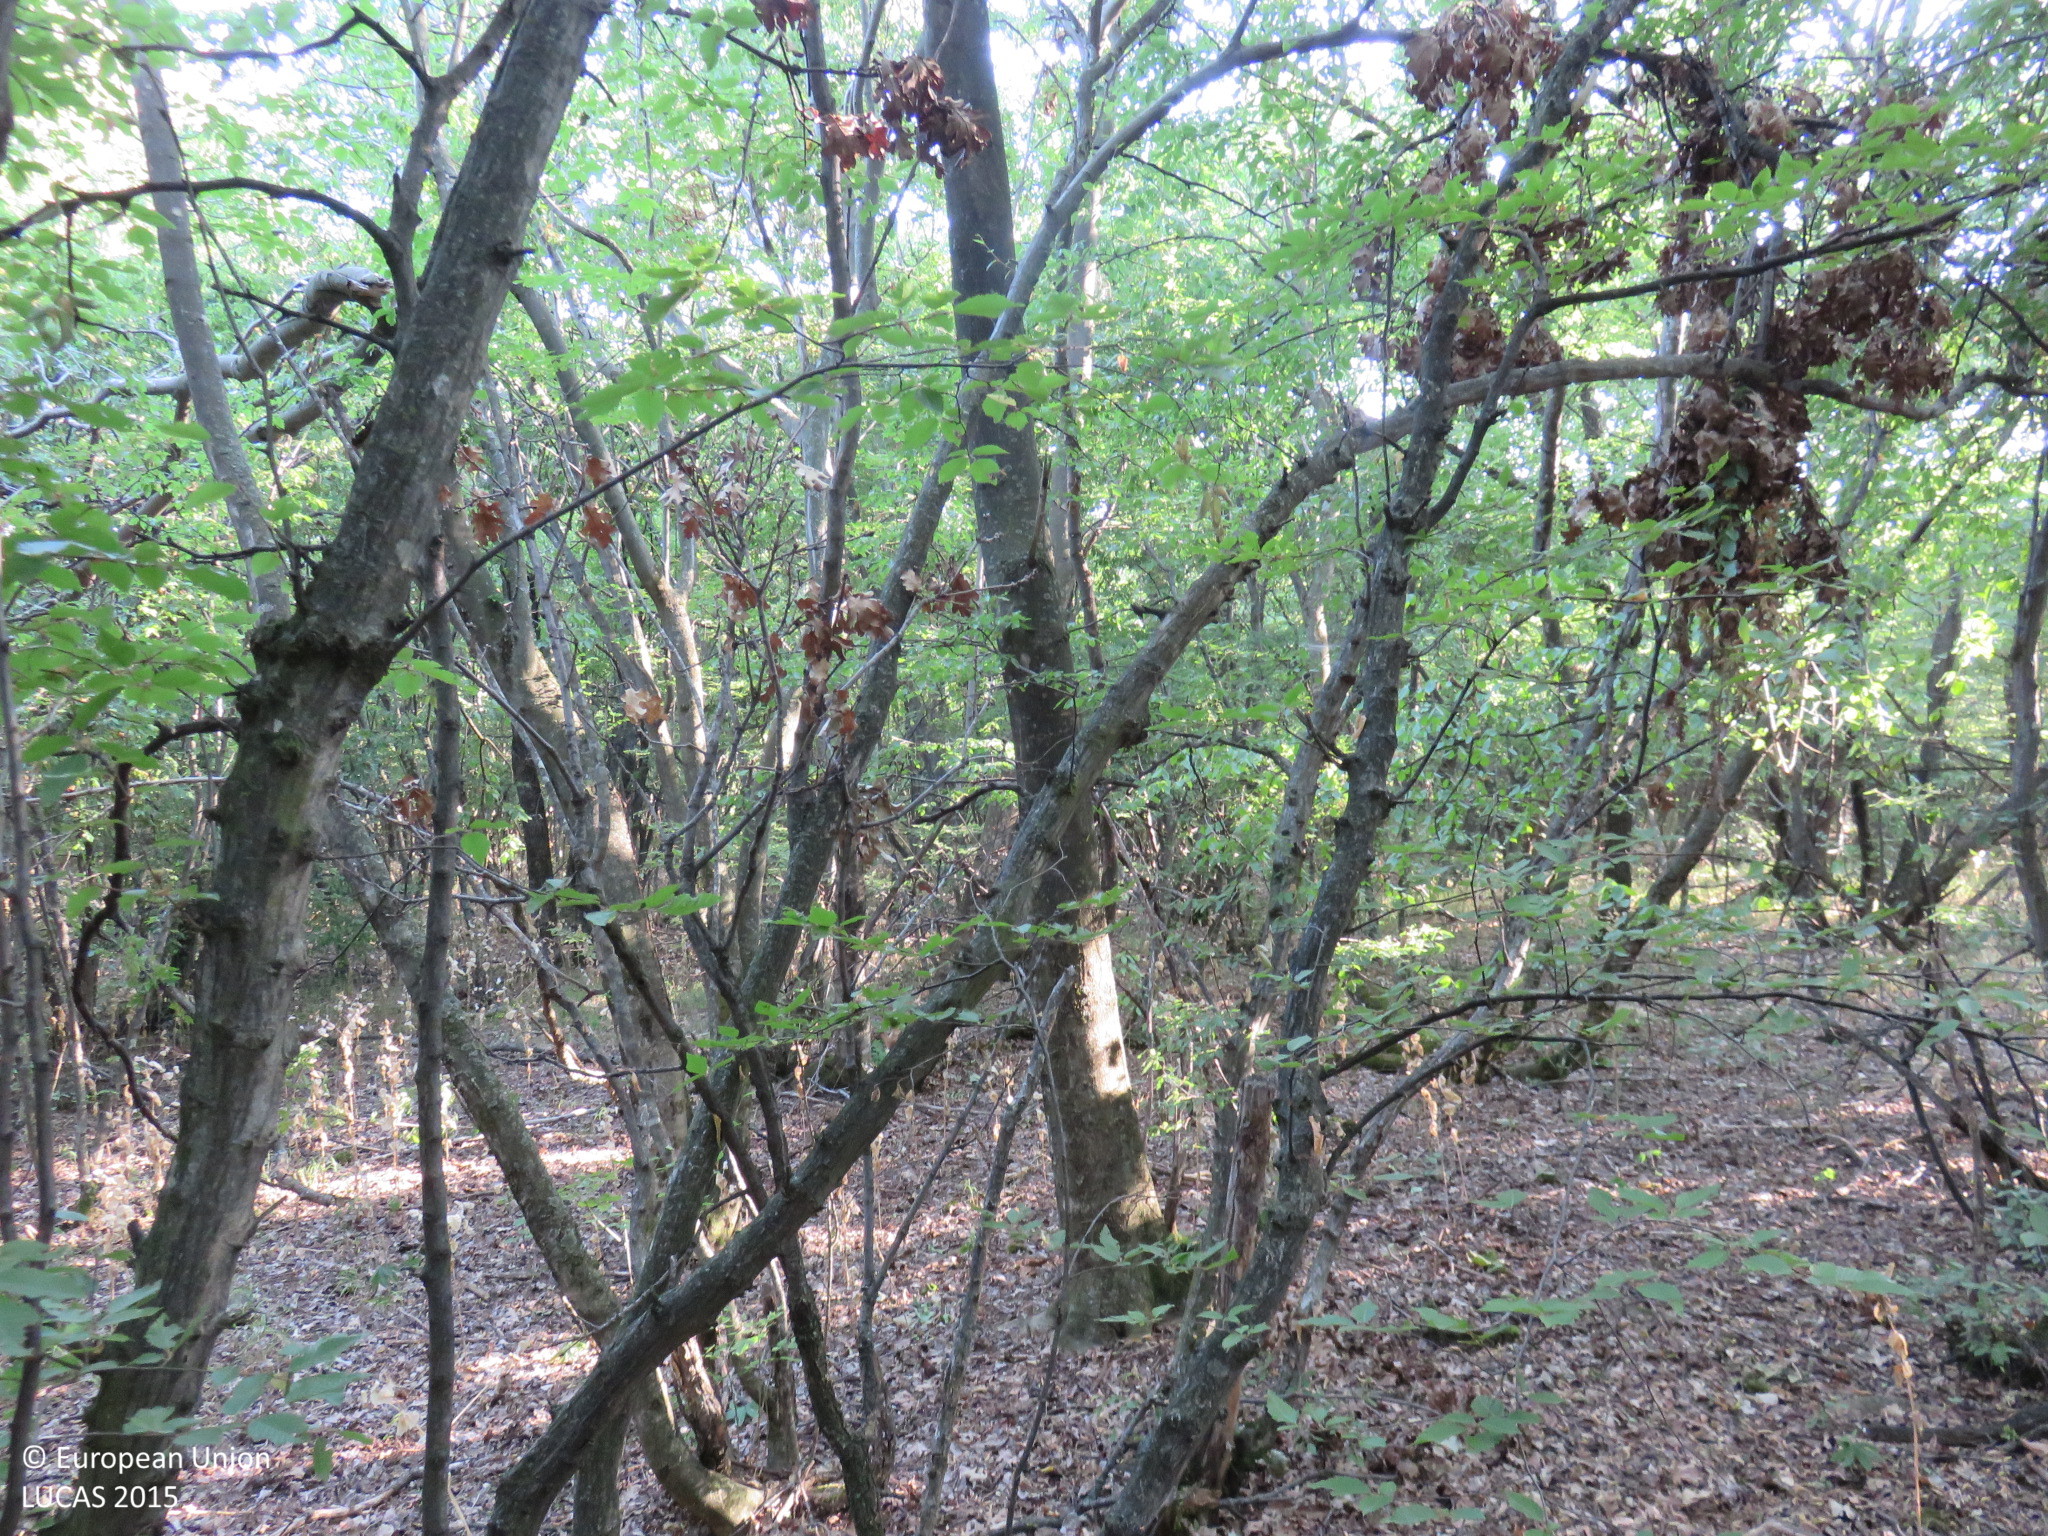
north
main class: Woodland
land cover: Broadleaved woodland
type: mesophytic deciduous forest
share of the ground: > 75 %
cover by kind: broadleaved forest trees 90 %, unconsolidated bare surface 10 %
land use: Forestry
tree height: < 5 m
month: July
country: BG
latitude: 43.2267
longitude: 25.0532
